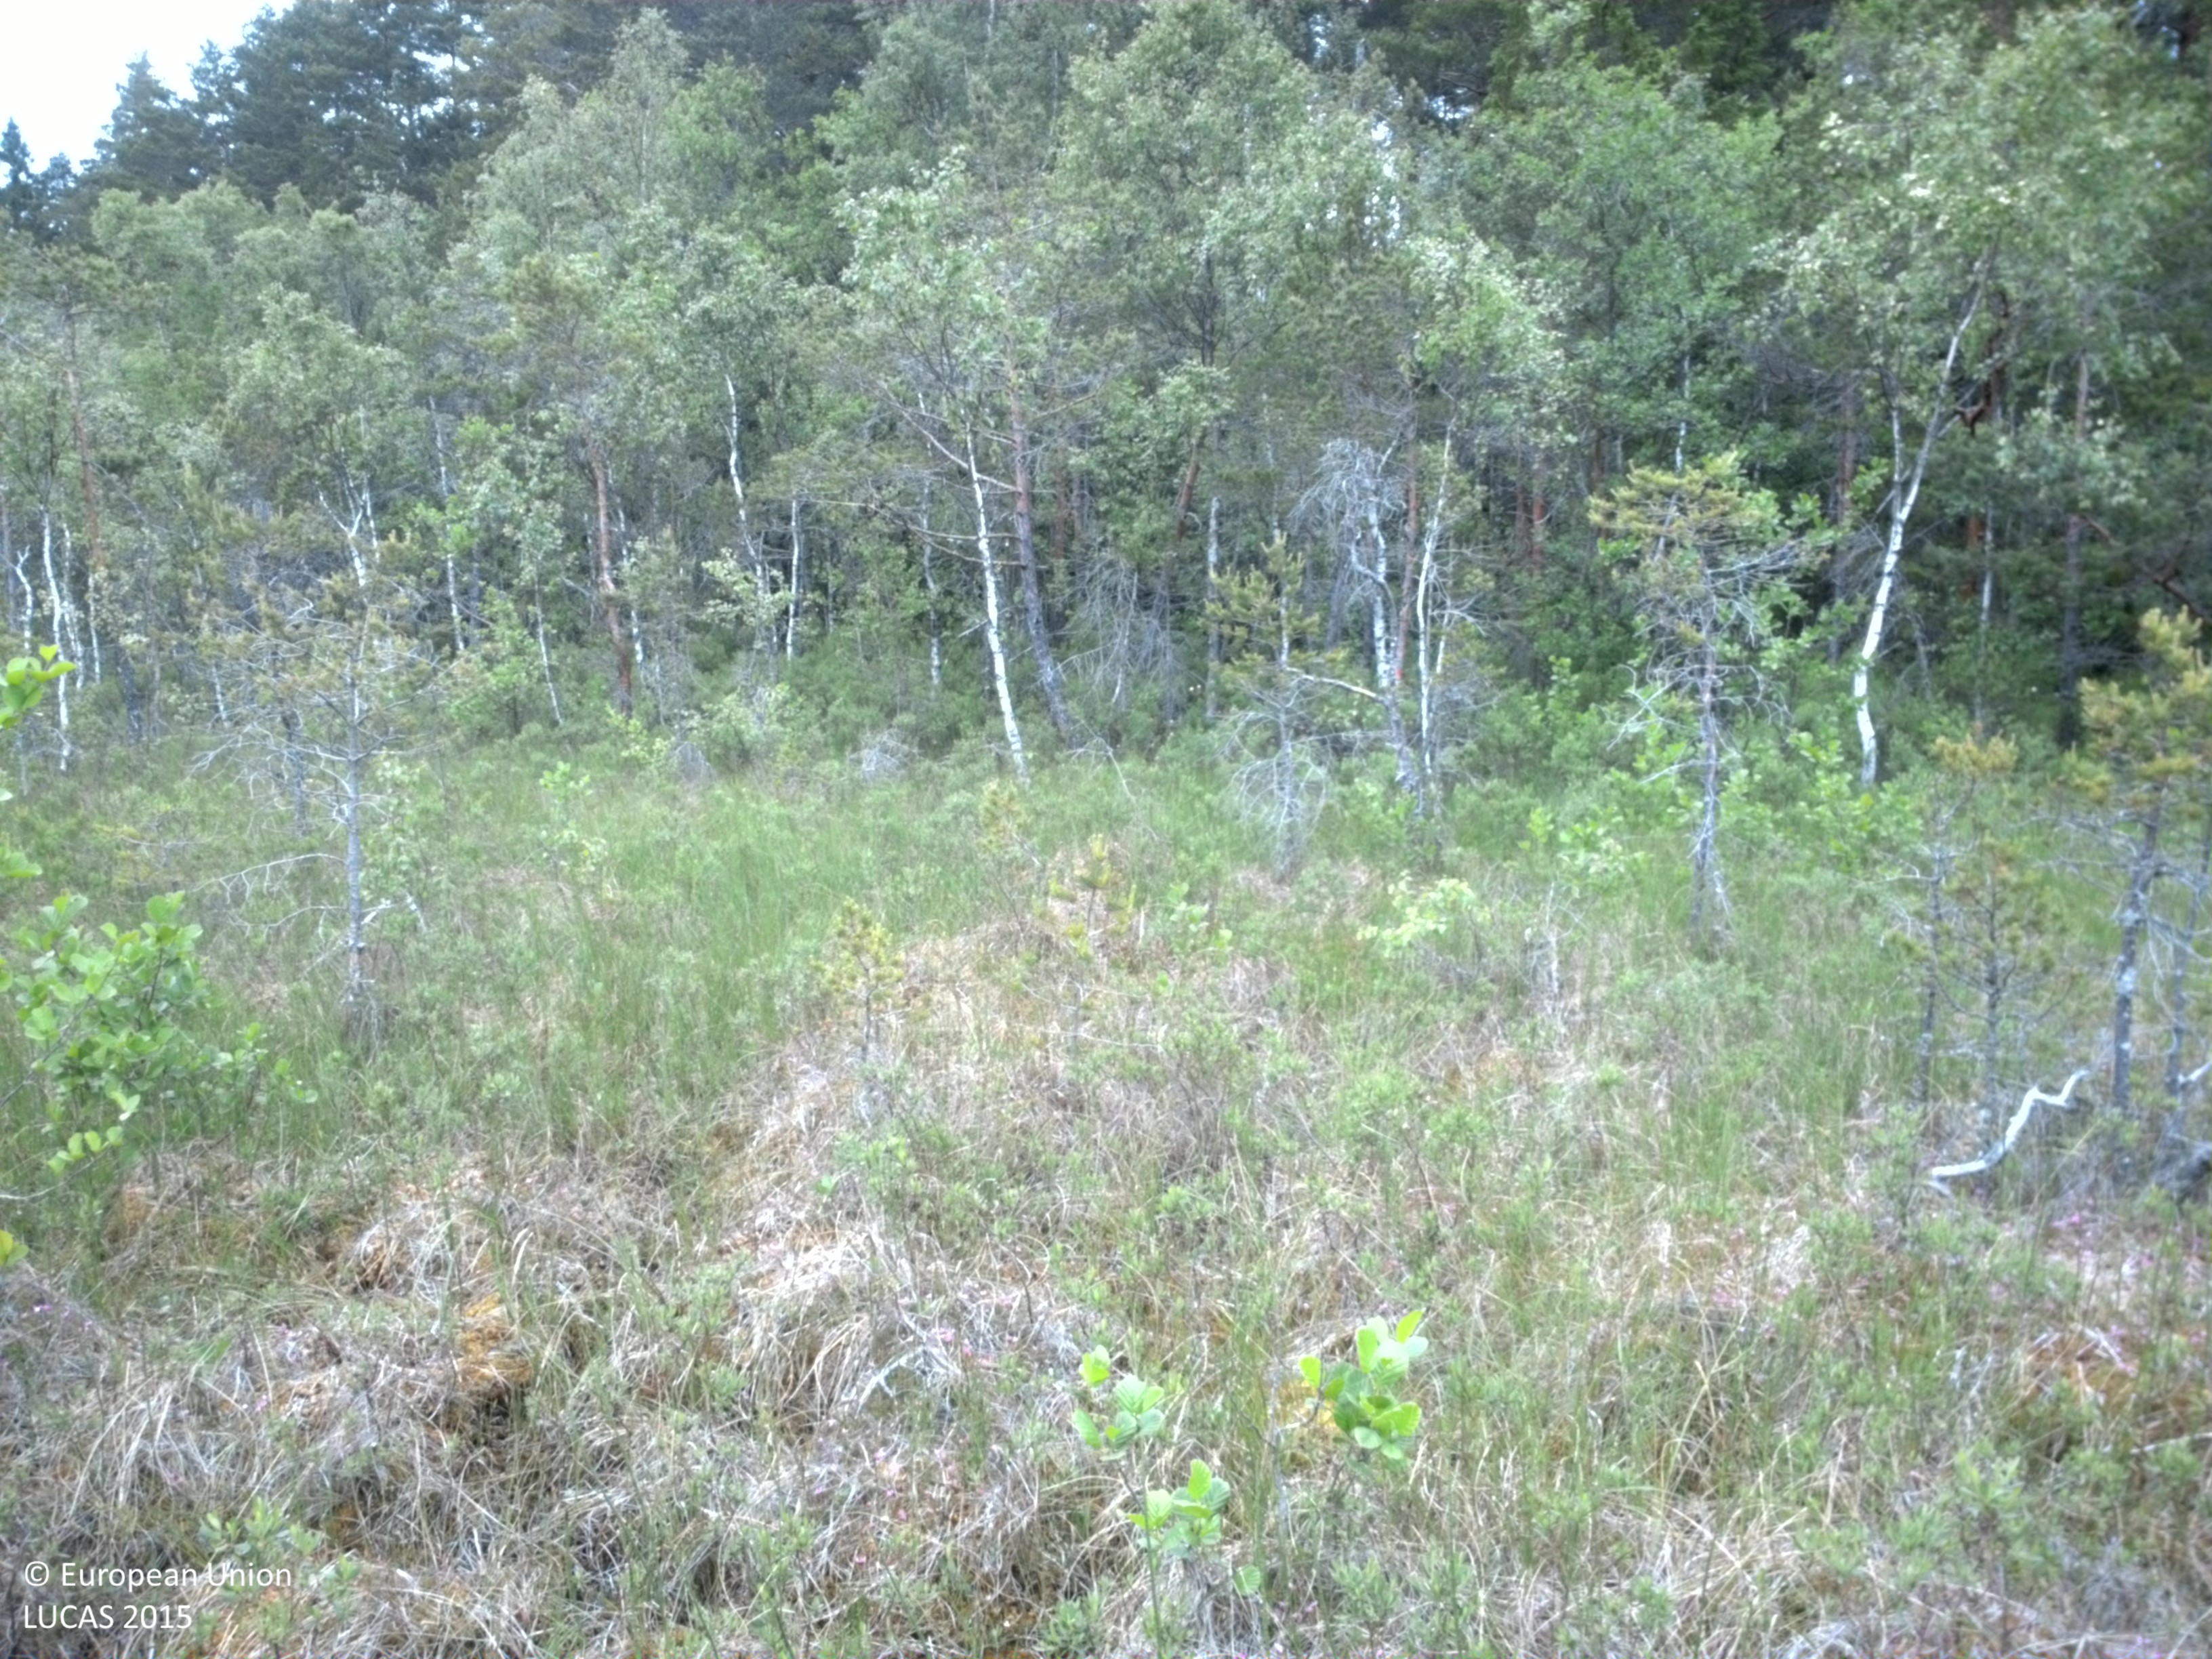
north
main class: Woodland
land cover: Pine dominated coniferous woodland
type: boreal forest
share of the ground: 10 - 25 %
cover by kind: lichens and mosses 50 %, herbaceous plants 35 %, coniferous forest trees 15 %
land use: Semi-natural and natural areas not in use
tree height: < 5 m
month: June
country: SE
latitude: 58.5264
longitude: 16.2288
